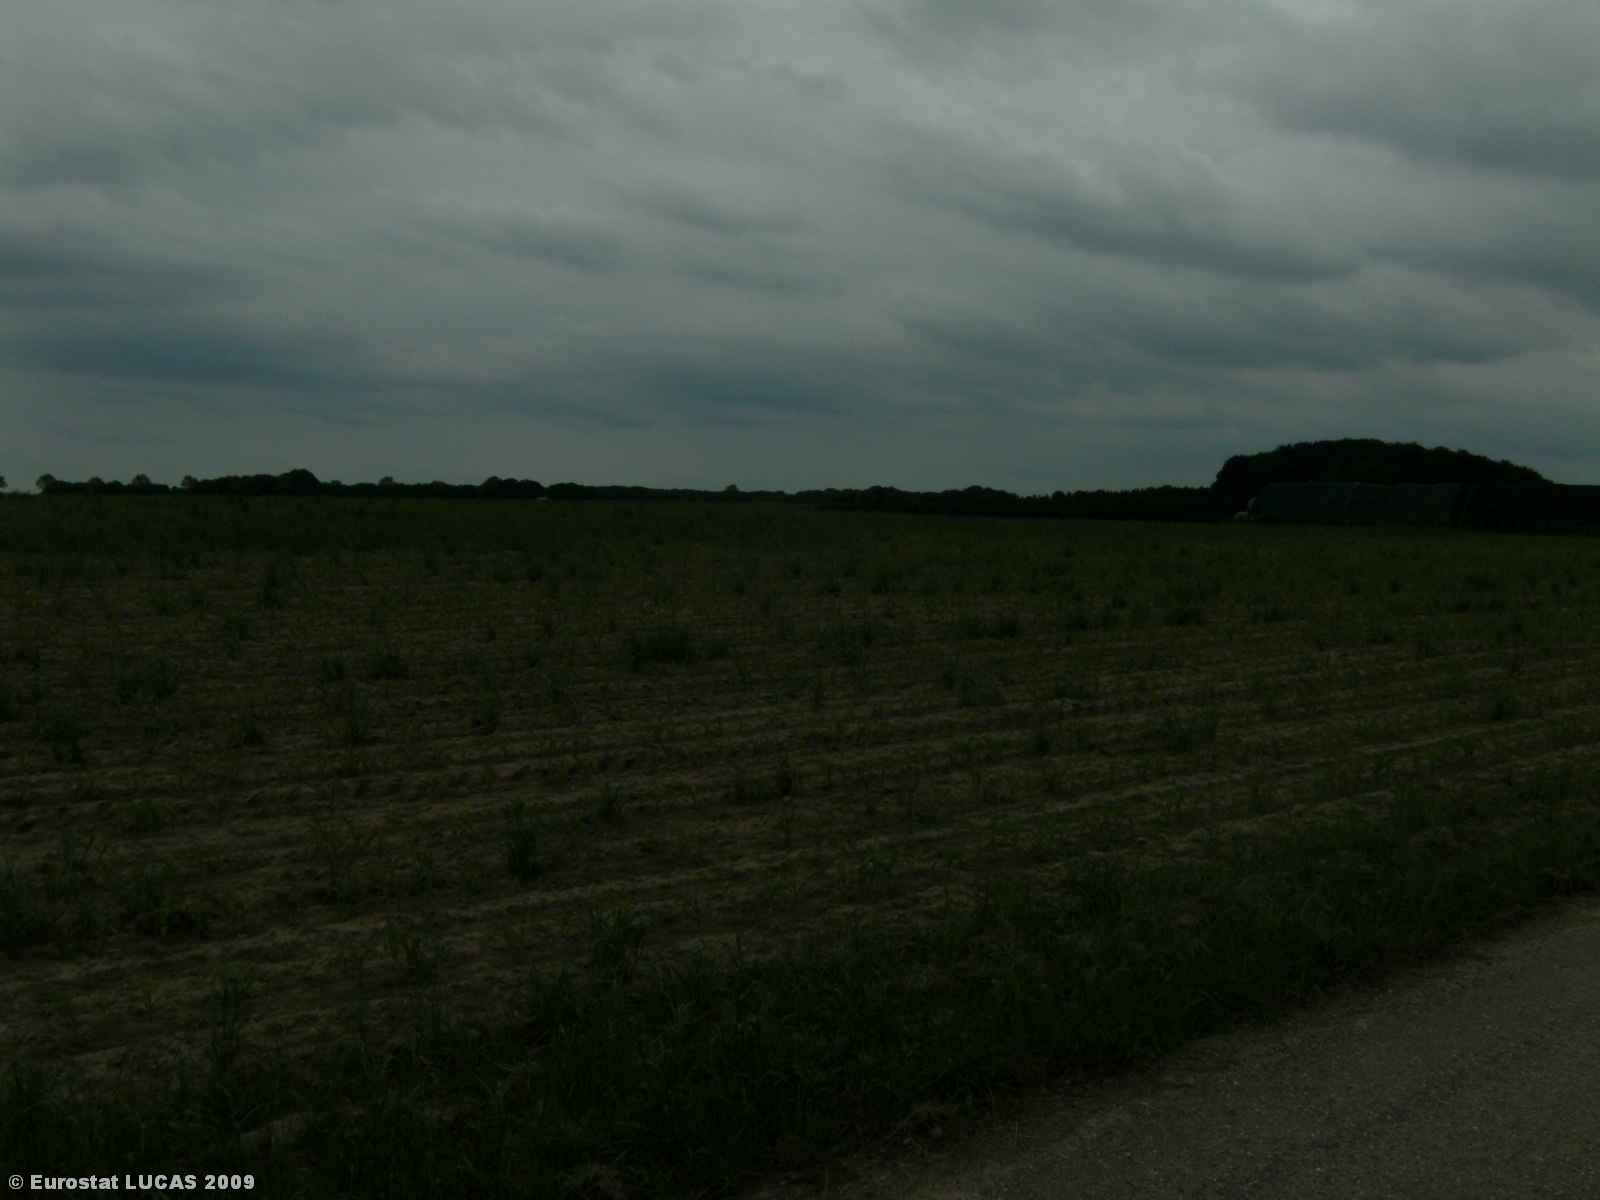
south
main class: Grassland
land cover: Grassland without tree/shrub cover
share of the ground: > 75 %
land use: Agriculture (excluding fallow land and kitchen gardens)
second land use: Telecommunication
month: June
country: LU
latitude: 49.7289
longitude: 6.3232
